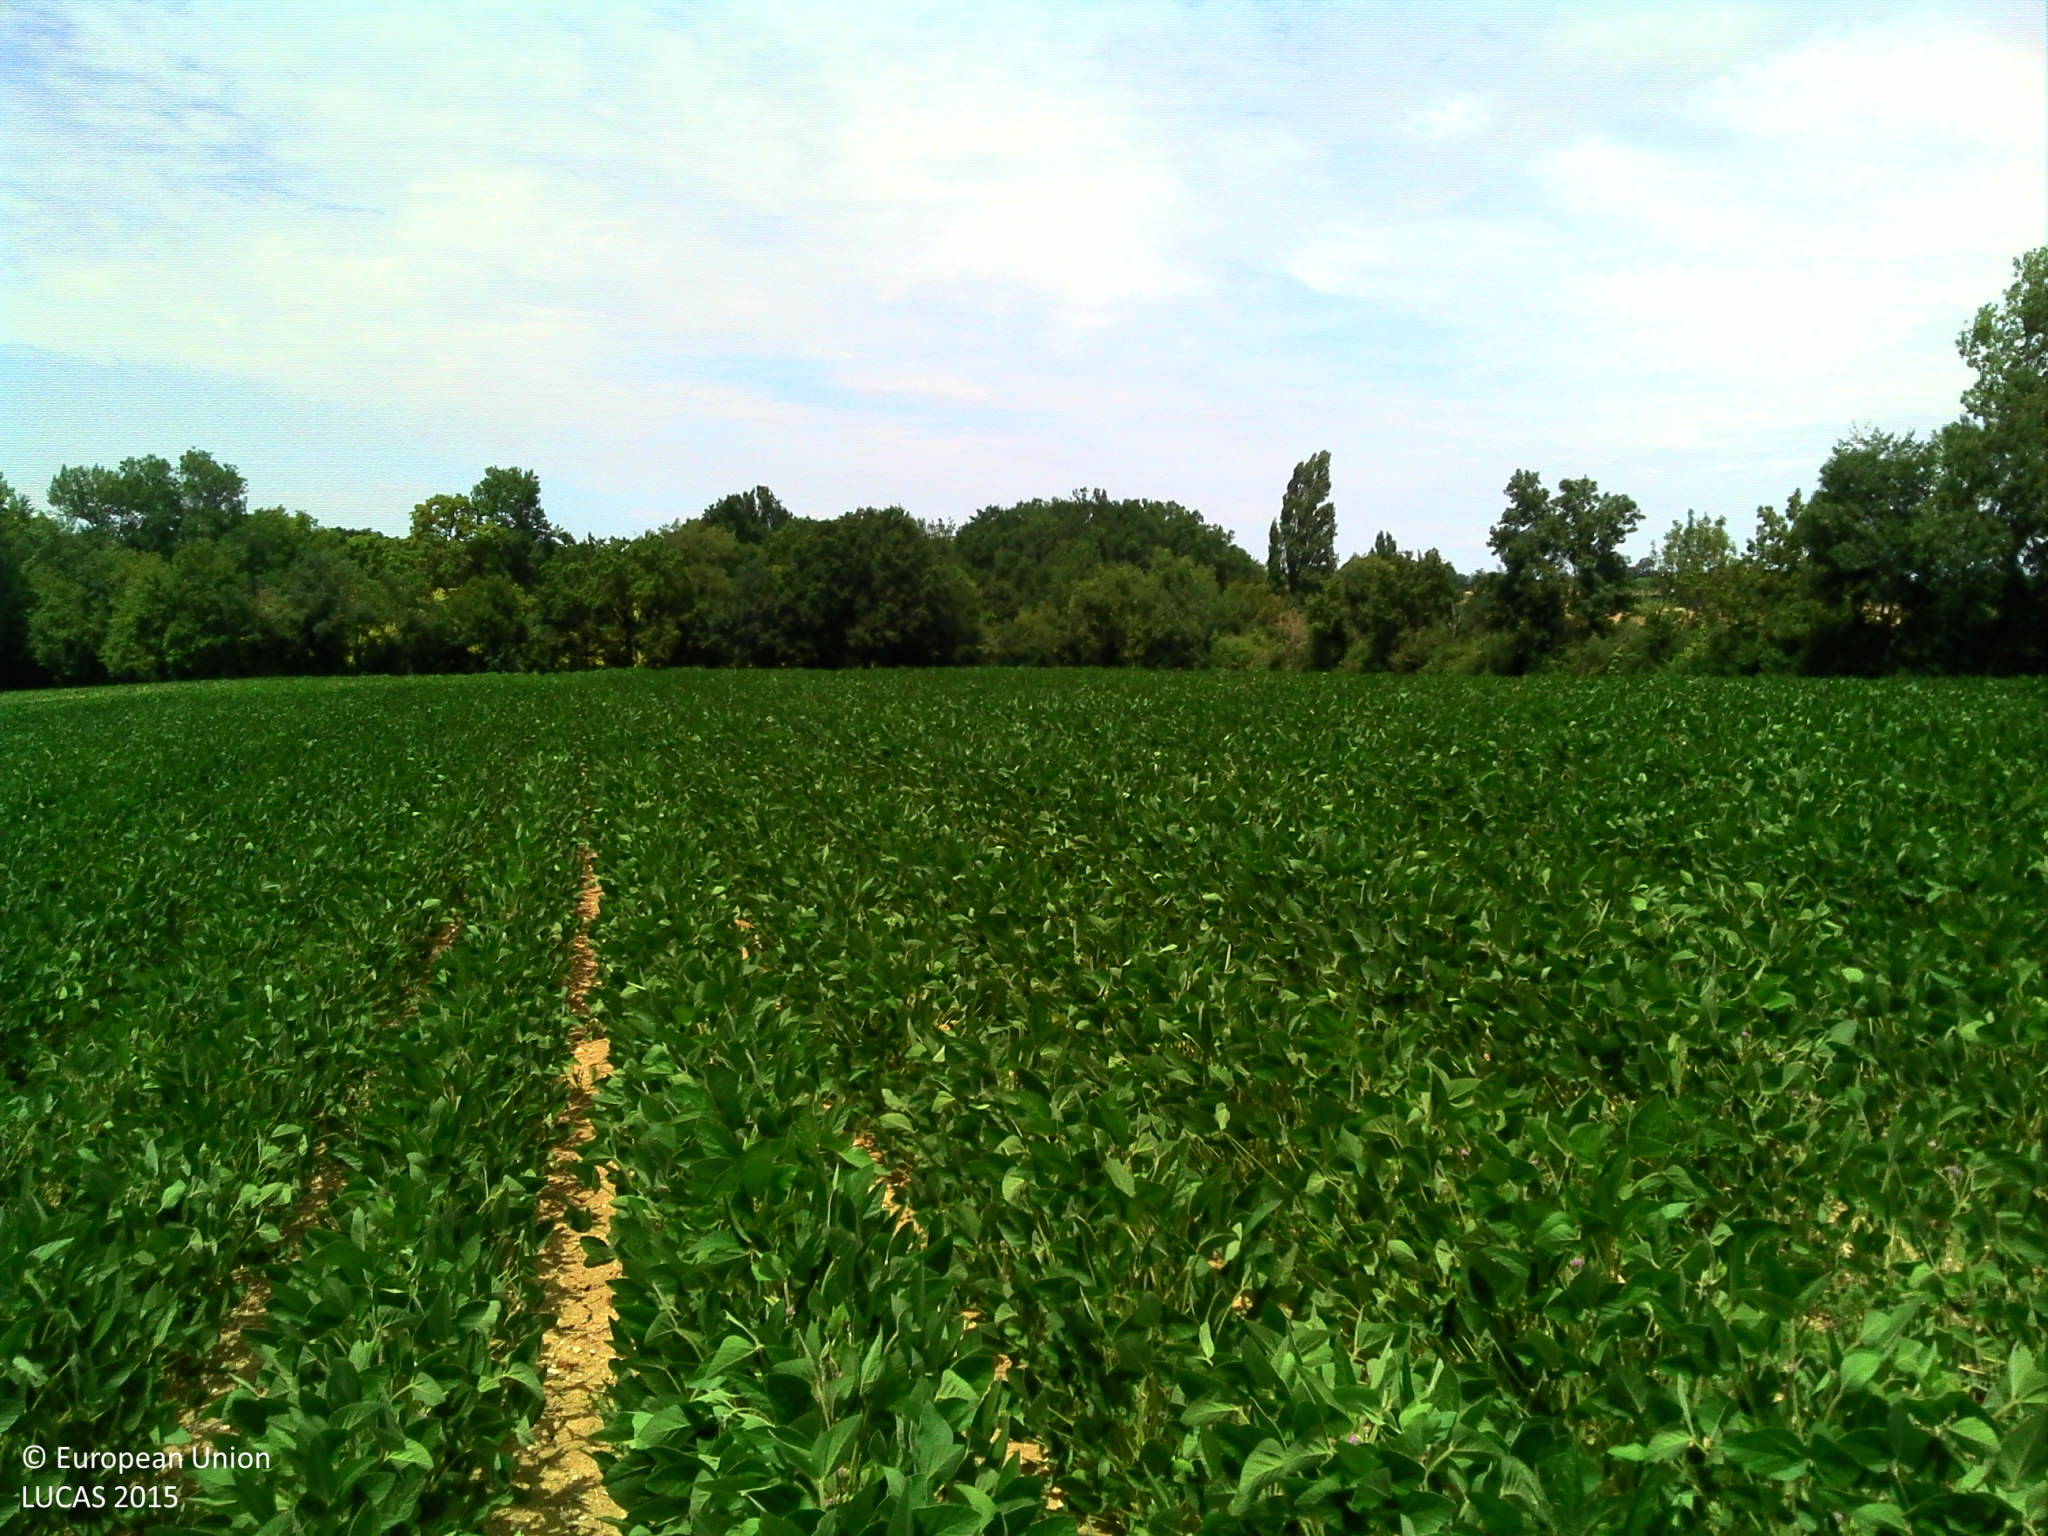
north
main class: Cropland
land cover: Soya
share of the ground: > 75 %
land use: Agriculture (excluding fallow land and kitchen gardens)
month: July
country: FR
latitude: 44.6442
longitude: 0.5483
